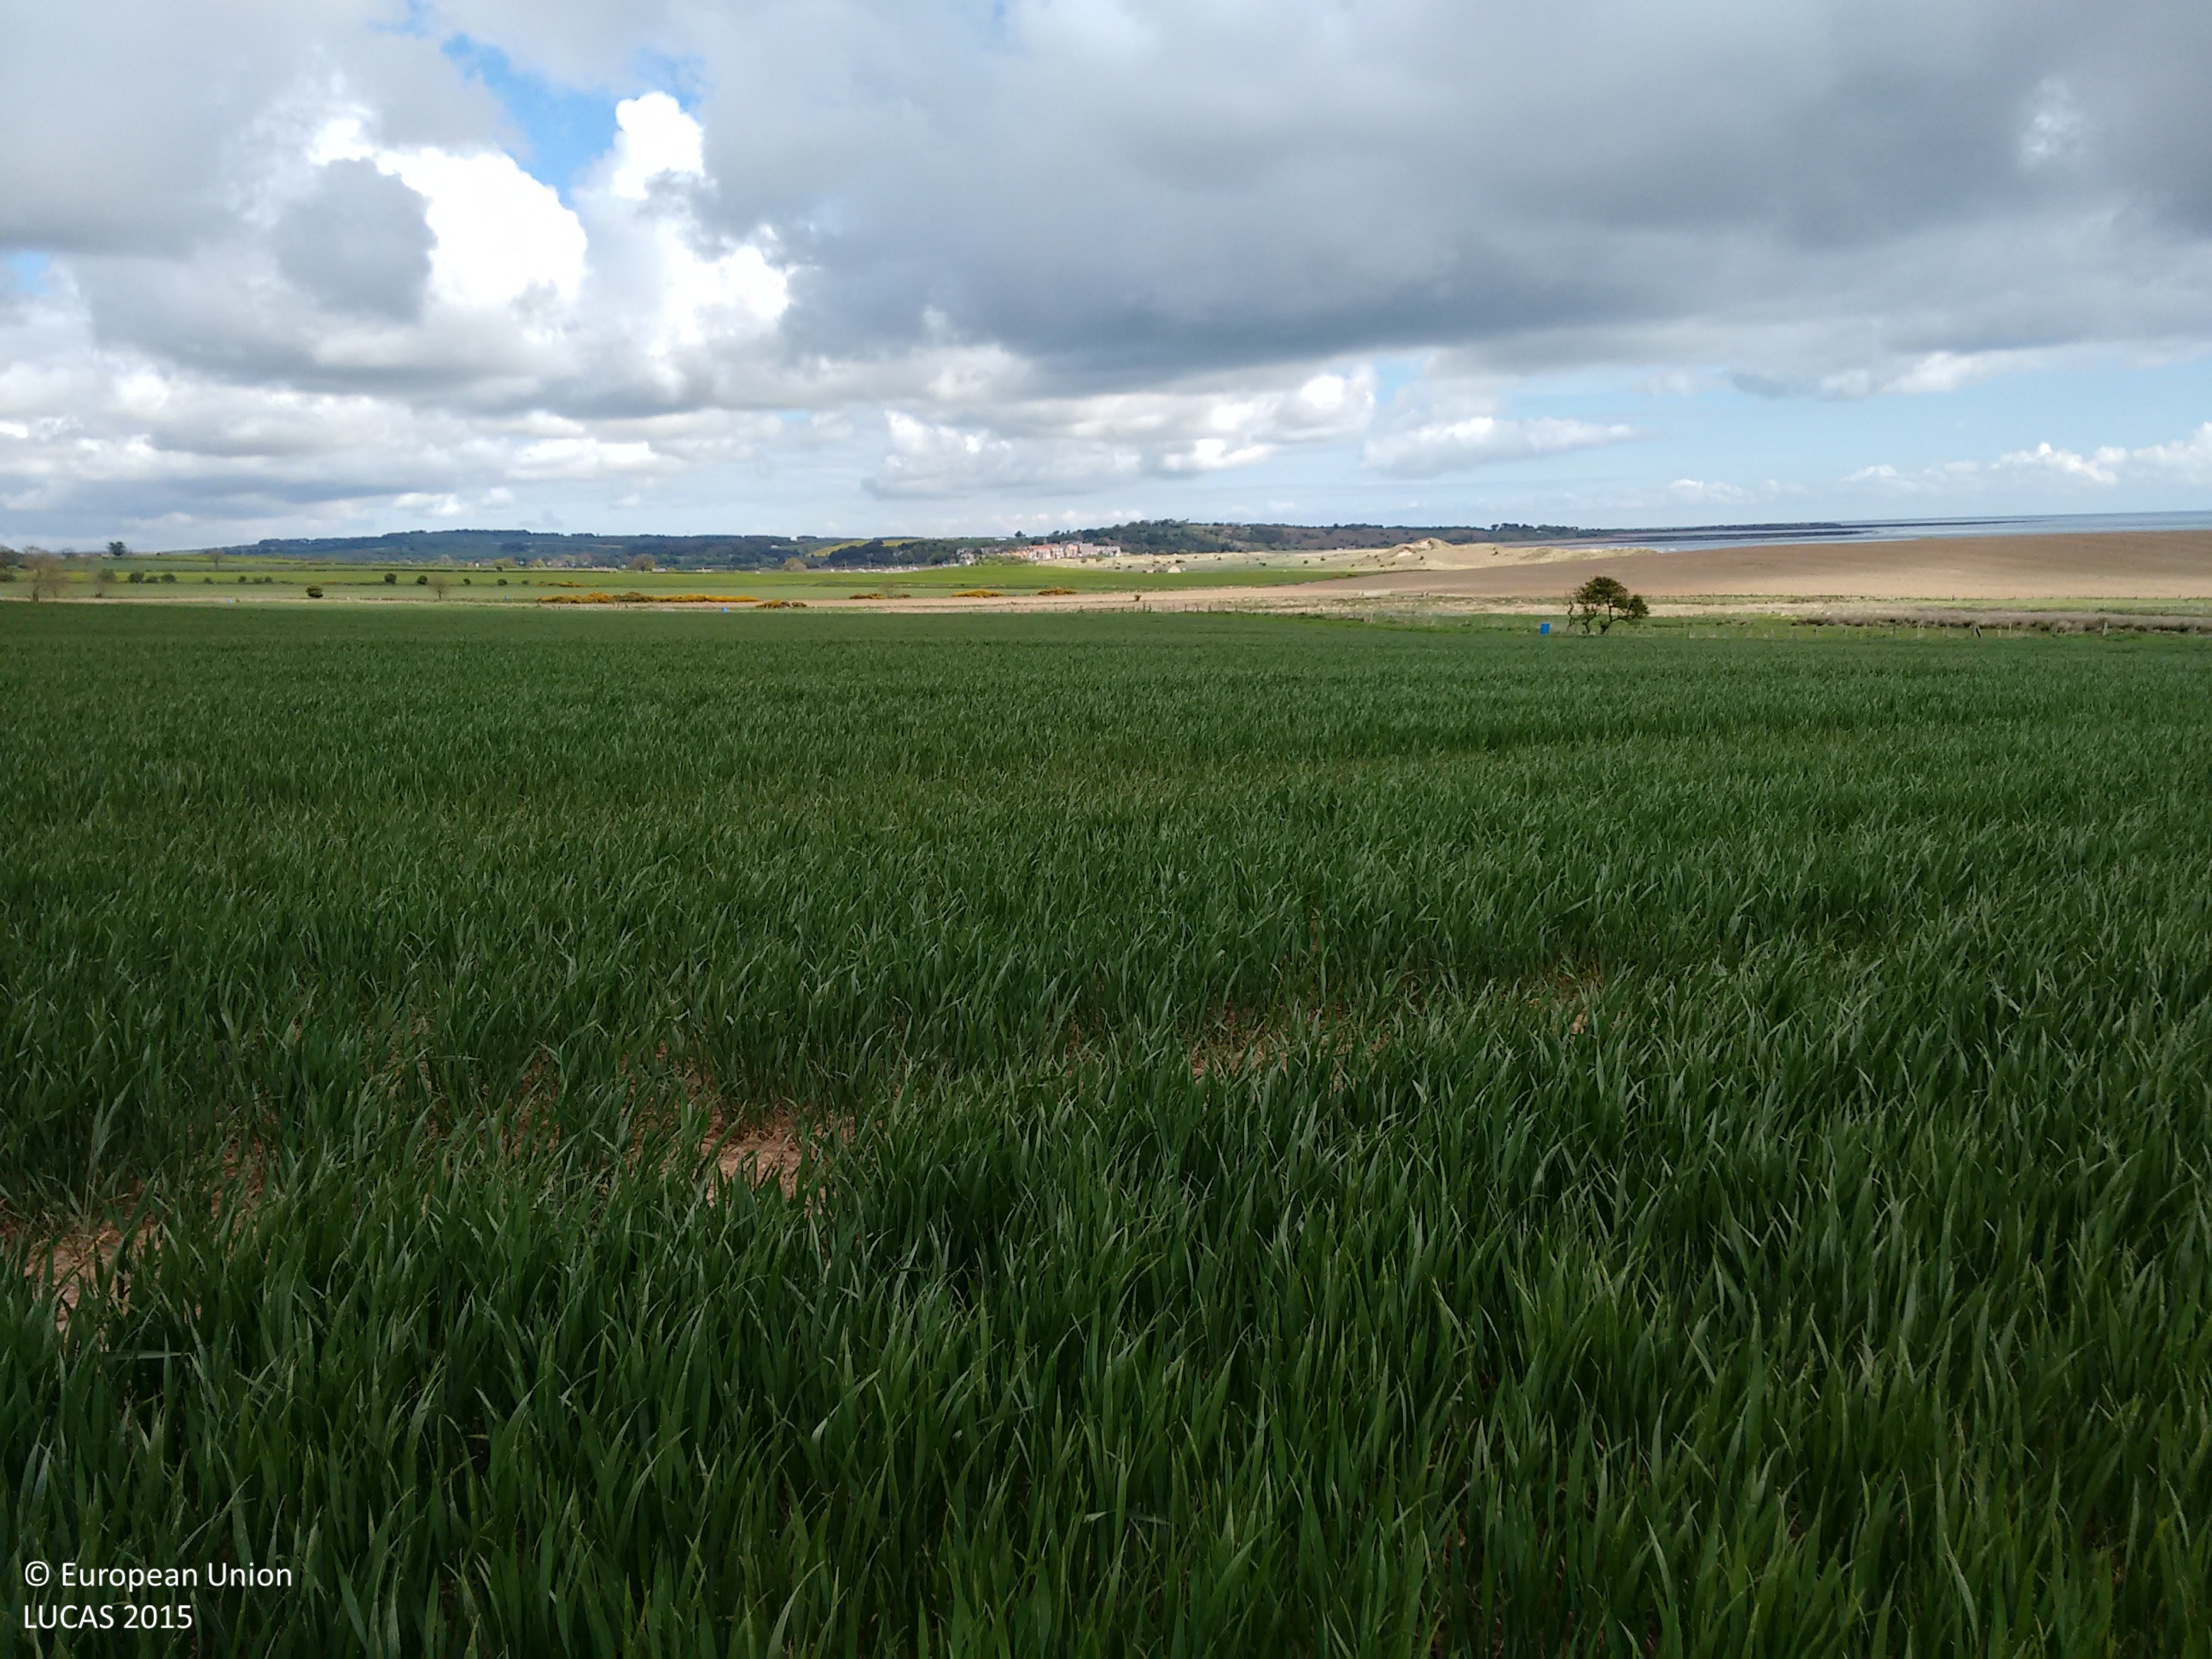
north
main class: Cropland
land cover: Common wheat
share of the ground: > 75 %
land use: Agriculture (excluding fallow land and kitchen gardens)
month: May
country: GB
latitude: 55.3675
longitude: -1.6128
